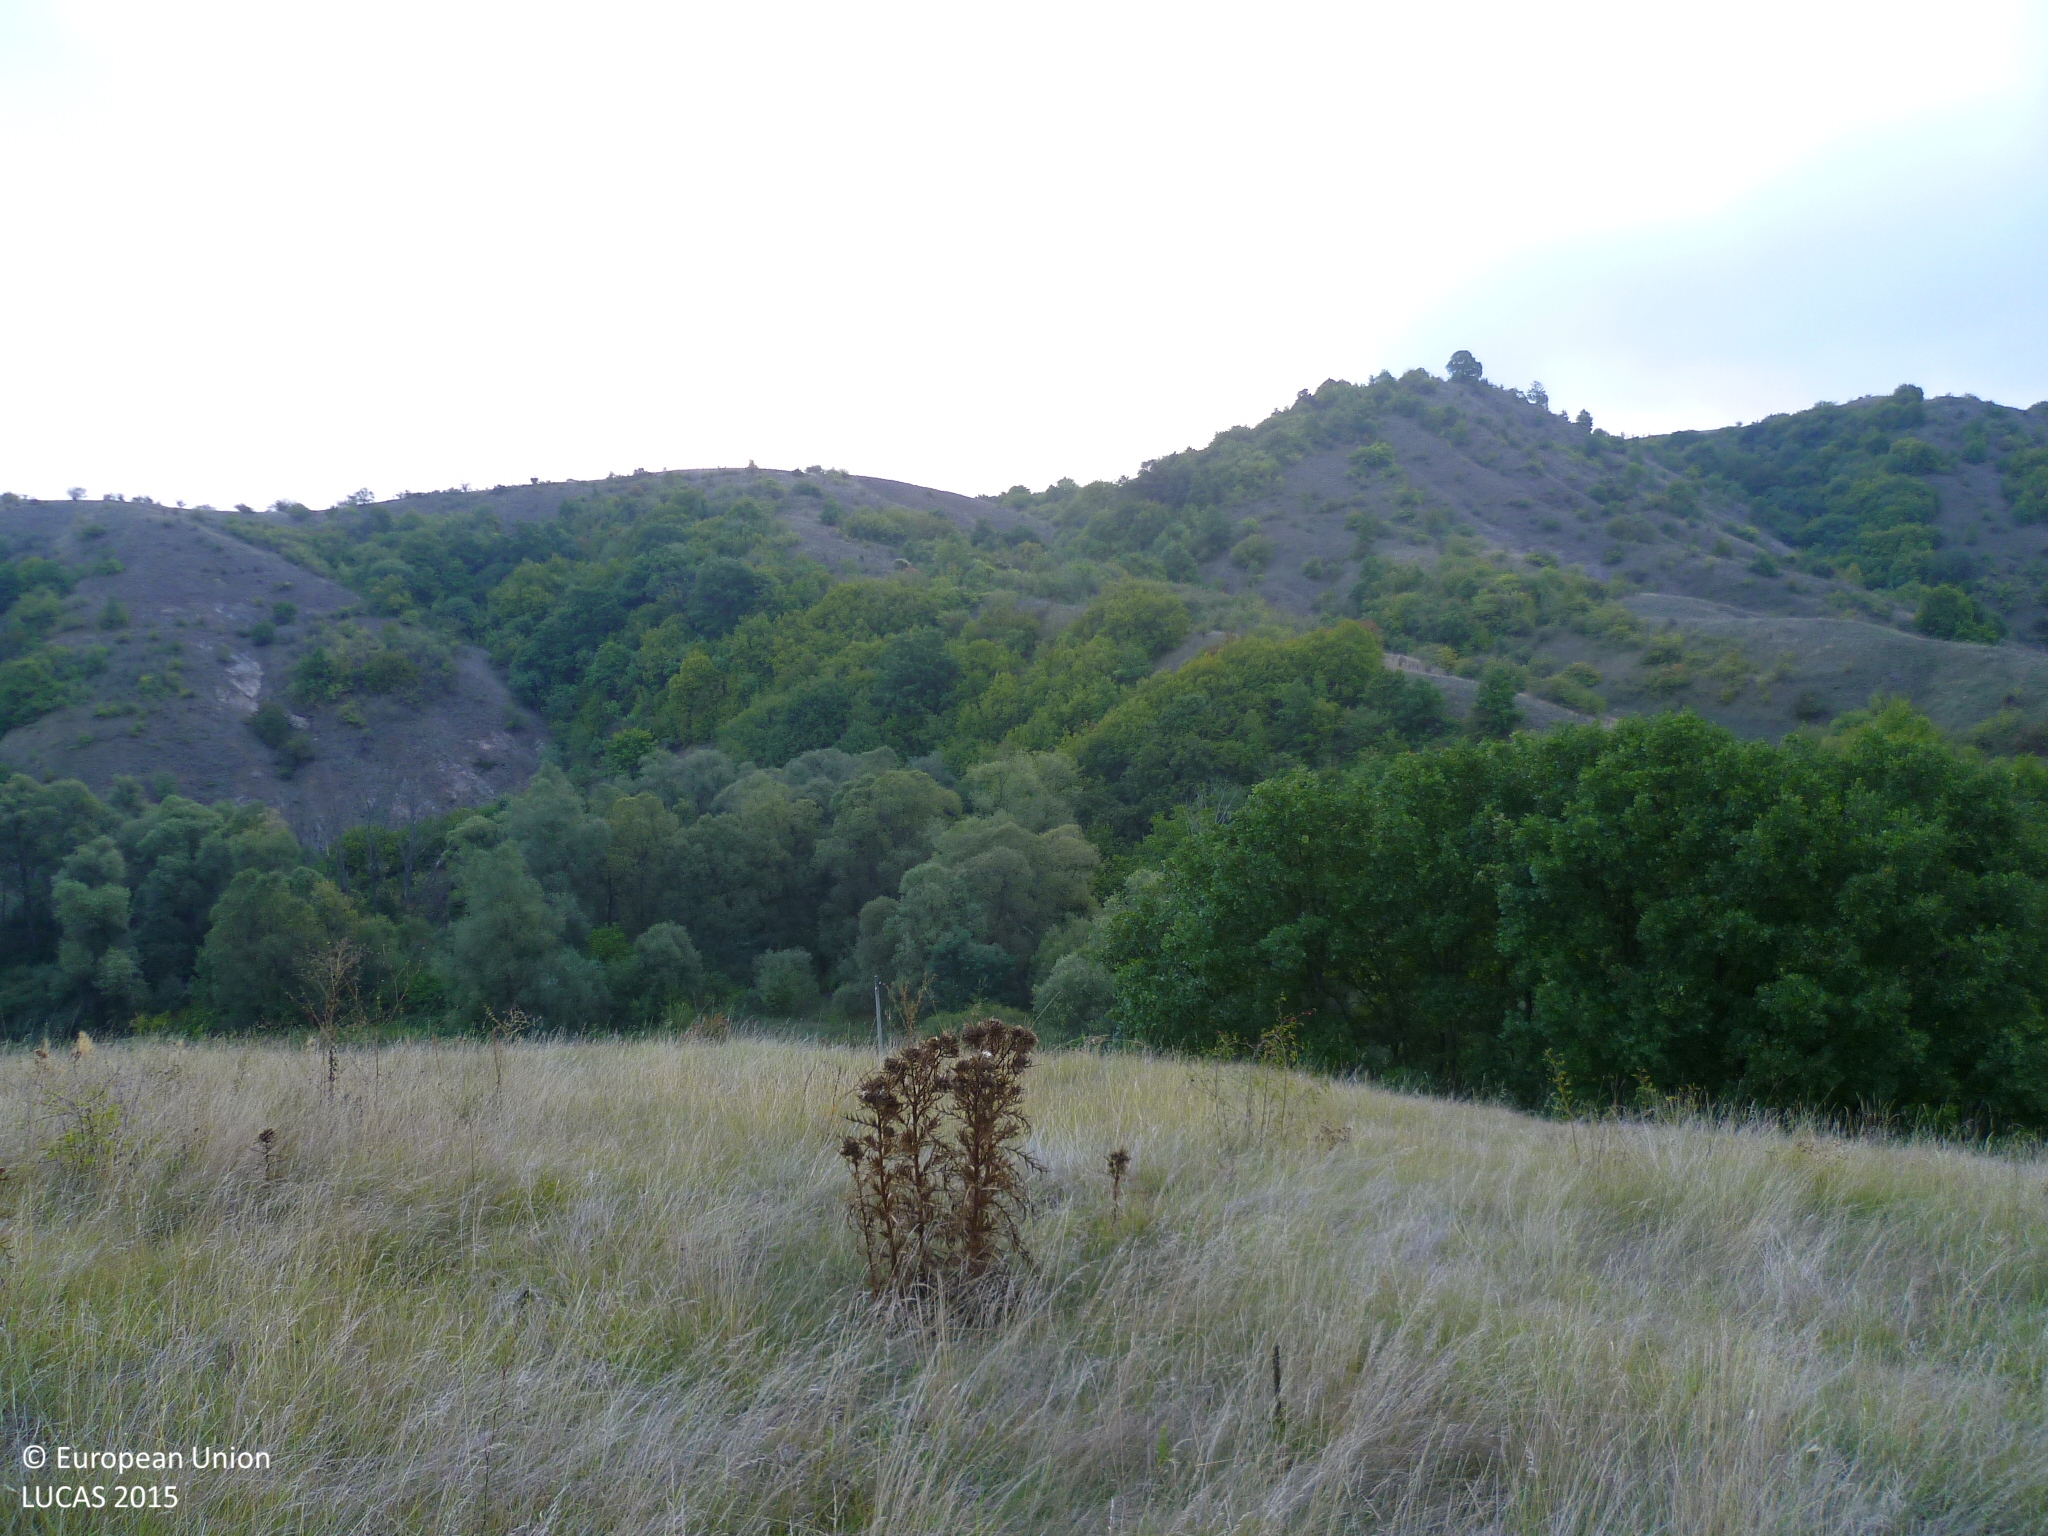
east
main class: Grassland
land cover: Grassland without tree/shrub cover
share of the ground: > 75 %
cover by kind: herbaceous plants 100 %
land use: Agriculture (excluding fallow land and kitchen gardens)
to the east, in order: Grassland without tree/shrub cover; Broadleaved woodland; Grassland with sparse tree/shrub cover; Electric lines; Tracks; Broadleaved woodland; Rivers and streams; Broadleaved woodland; Grassland without tree/shrub cover; Broadleaved woodland
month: September
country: BG
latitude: 42.7888
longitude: 23.0757
